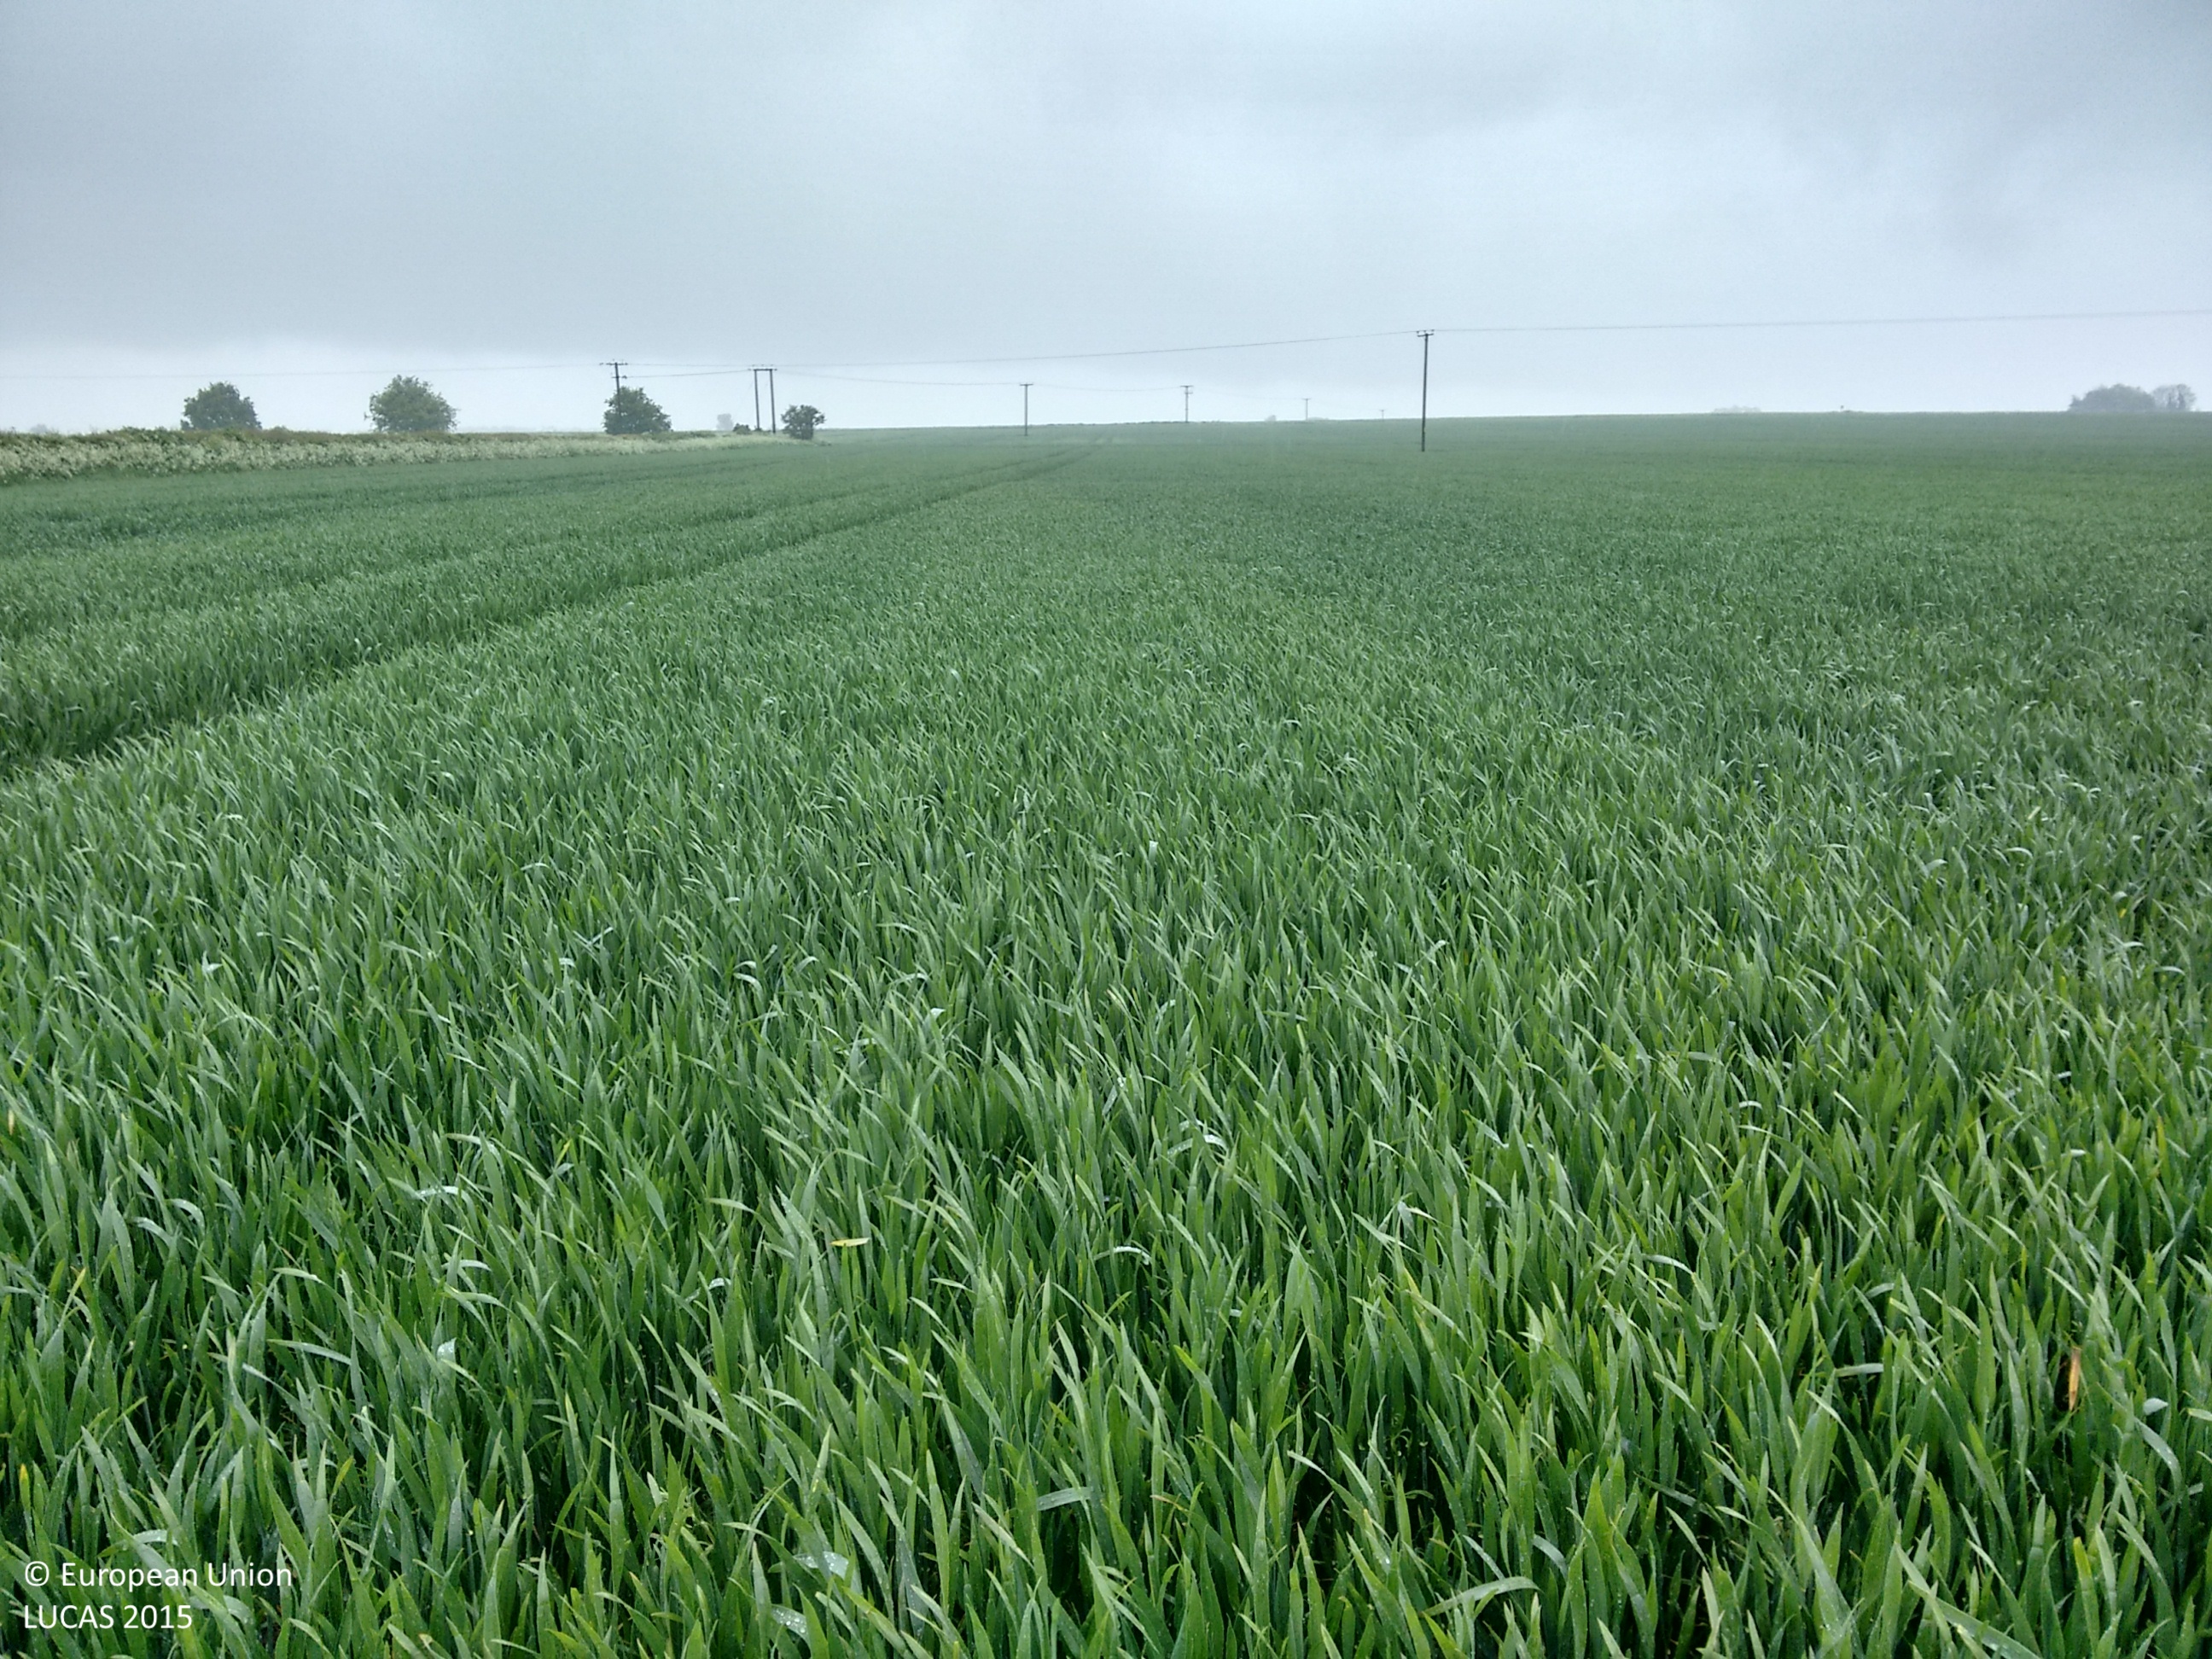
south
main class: Cropland
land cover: Common wheat
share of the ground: > 75 %
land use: Agriculture (excluding fallow land and kitchen gardens)
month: May
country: GB
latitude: 53.3225
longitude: -0.3191
